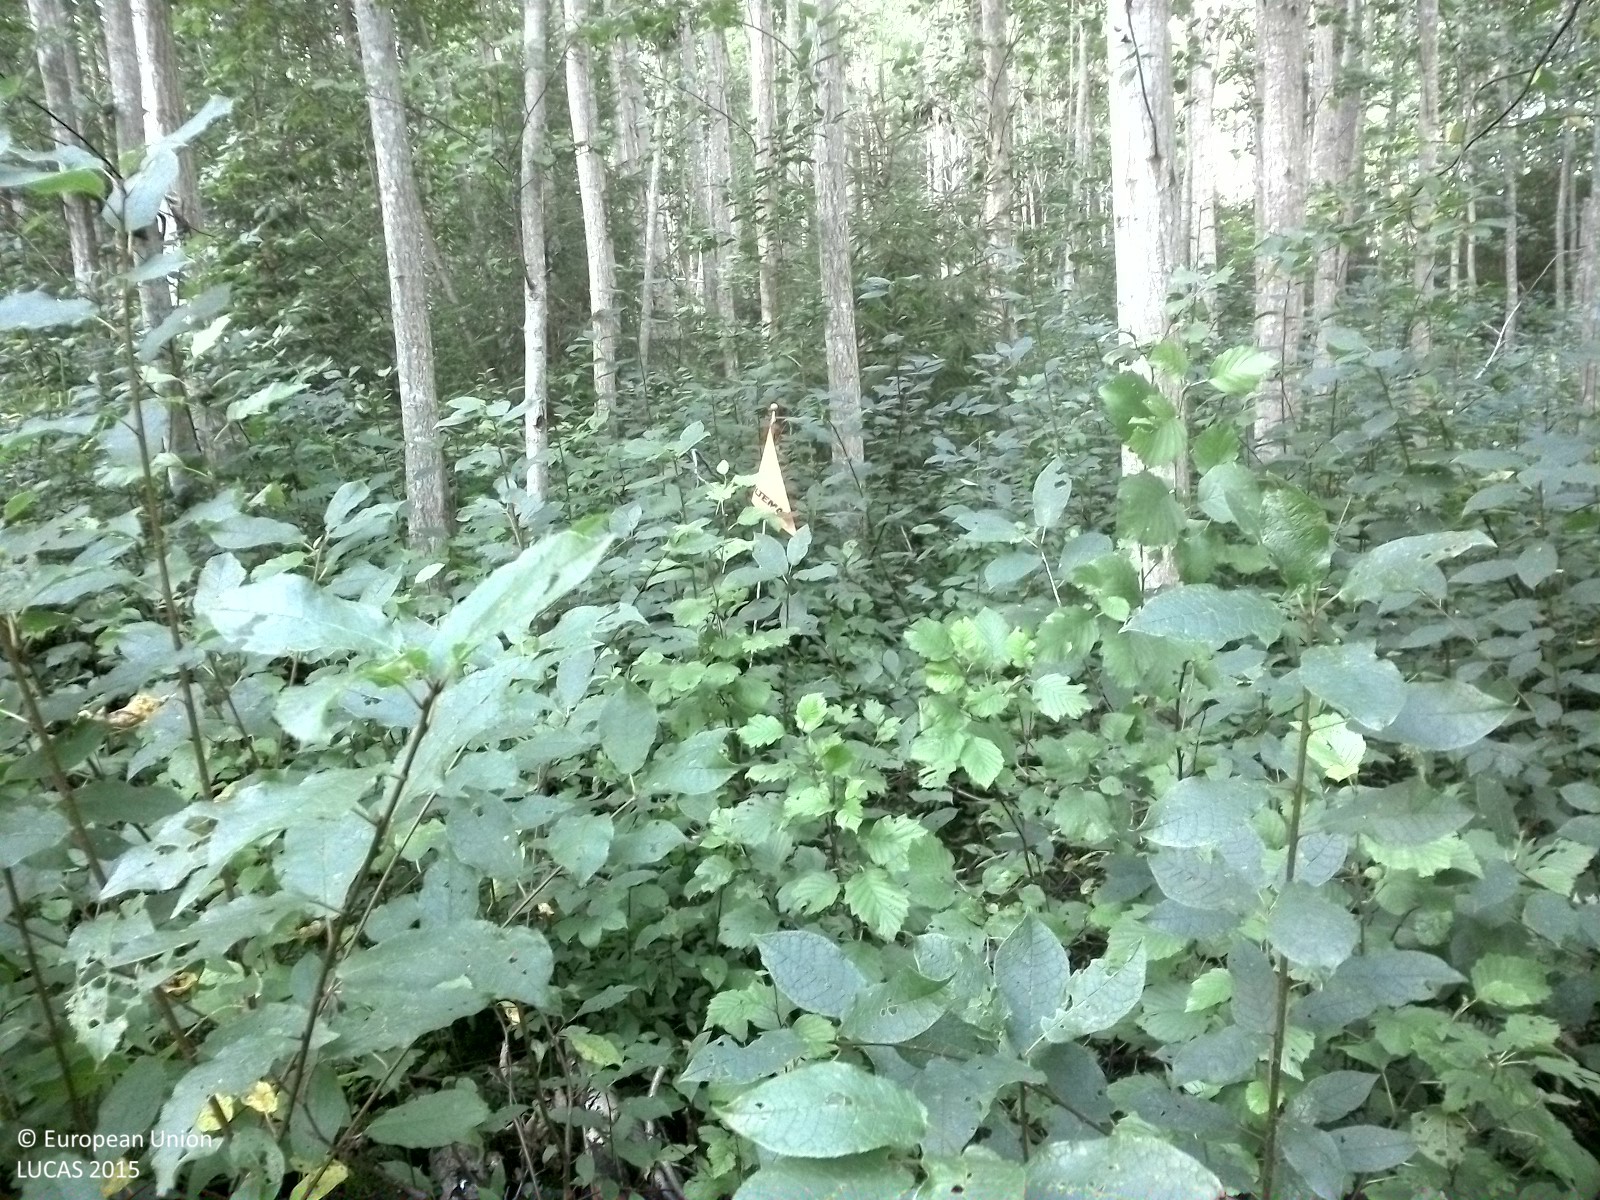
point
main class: Woodland
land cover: Broadleaved woodland
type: hemiboreal forest and nemoral coniferous forest and mixed broadleaved-coniferous forest
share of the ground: 50 - 75 %
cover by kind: broadleaved forest trees 65 %, shrubs 10 %, herbaceous plants 10 %, coniferous forest trees 5 %, lichens and mosses 5 %, unconsolidated bare surface 5 %
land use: Forestry
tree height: > 5 m
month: August
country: SE
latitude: 59.1324
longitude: 15.5667
